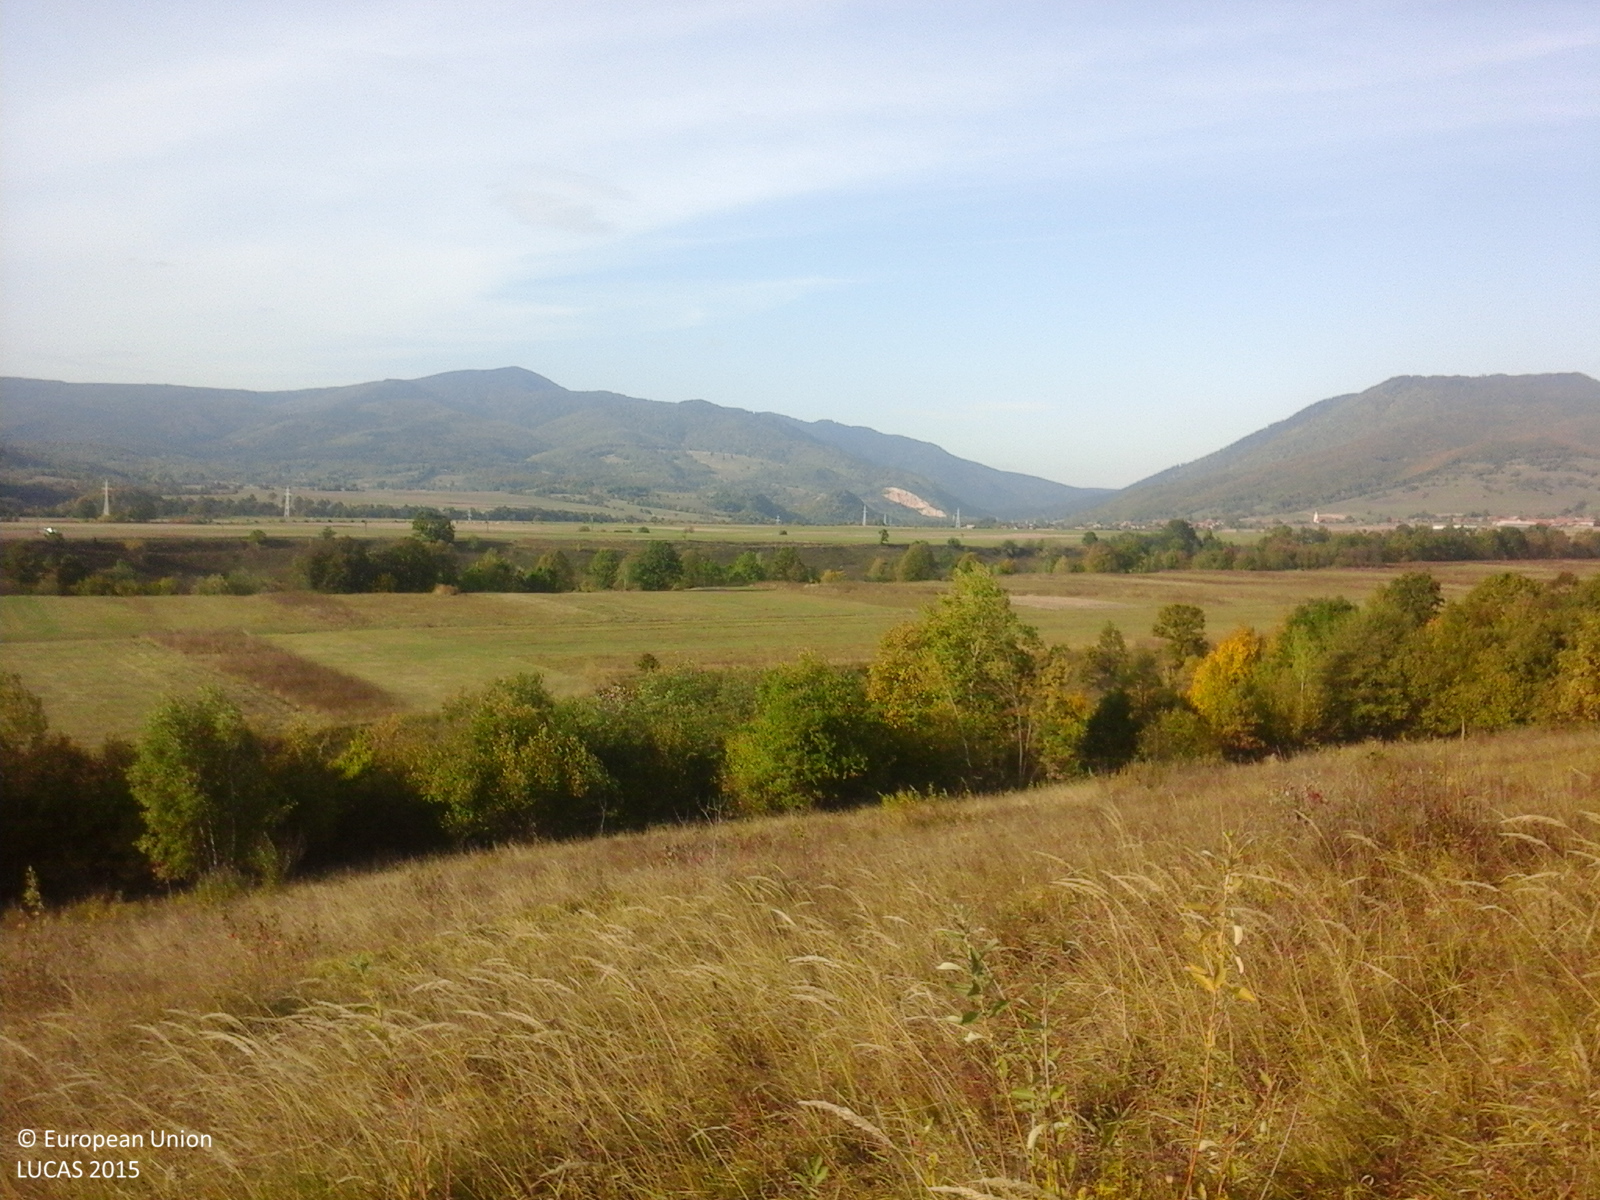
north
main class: Grassland
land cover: Grassland with sparse tree/shrub cover
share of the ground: > 75 %
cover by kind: herbaceous plants 95 %, broadleaved forest trees 5 %
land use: Agriculture (excluding fallow land and kitchen gardens)
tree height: > 5 m
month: October
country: RO
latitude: 46.0769
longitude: 25.8502
